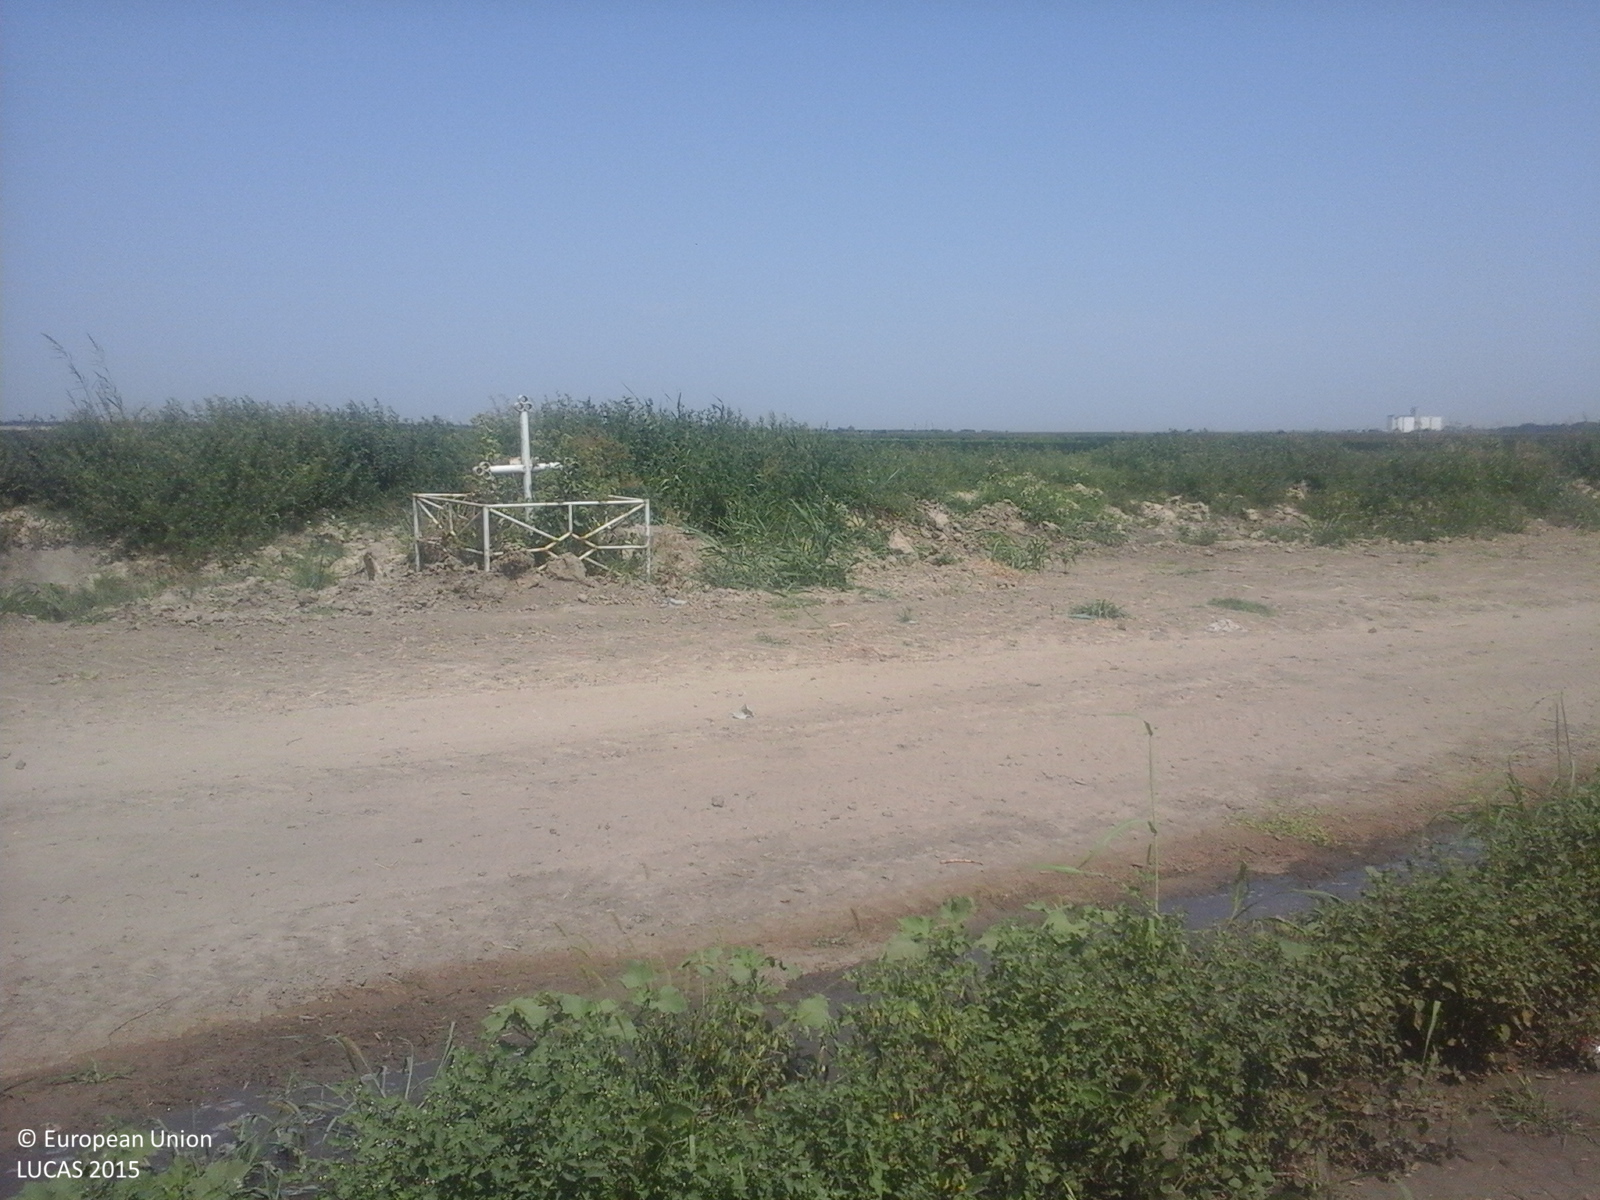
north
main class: Cropland
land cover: Soya
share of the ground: > 75 %
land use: Agriculture (excluding fallow land and kitchen gardens)
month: August
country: RO
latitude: 45.1551
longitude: 27.6971
